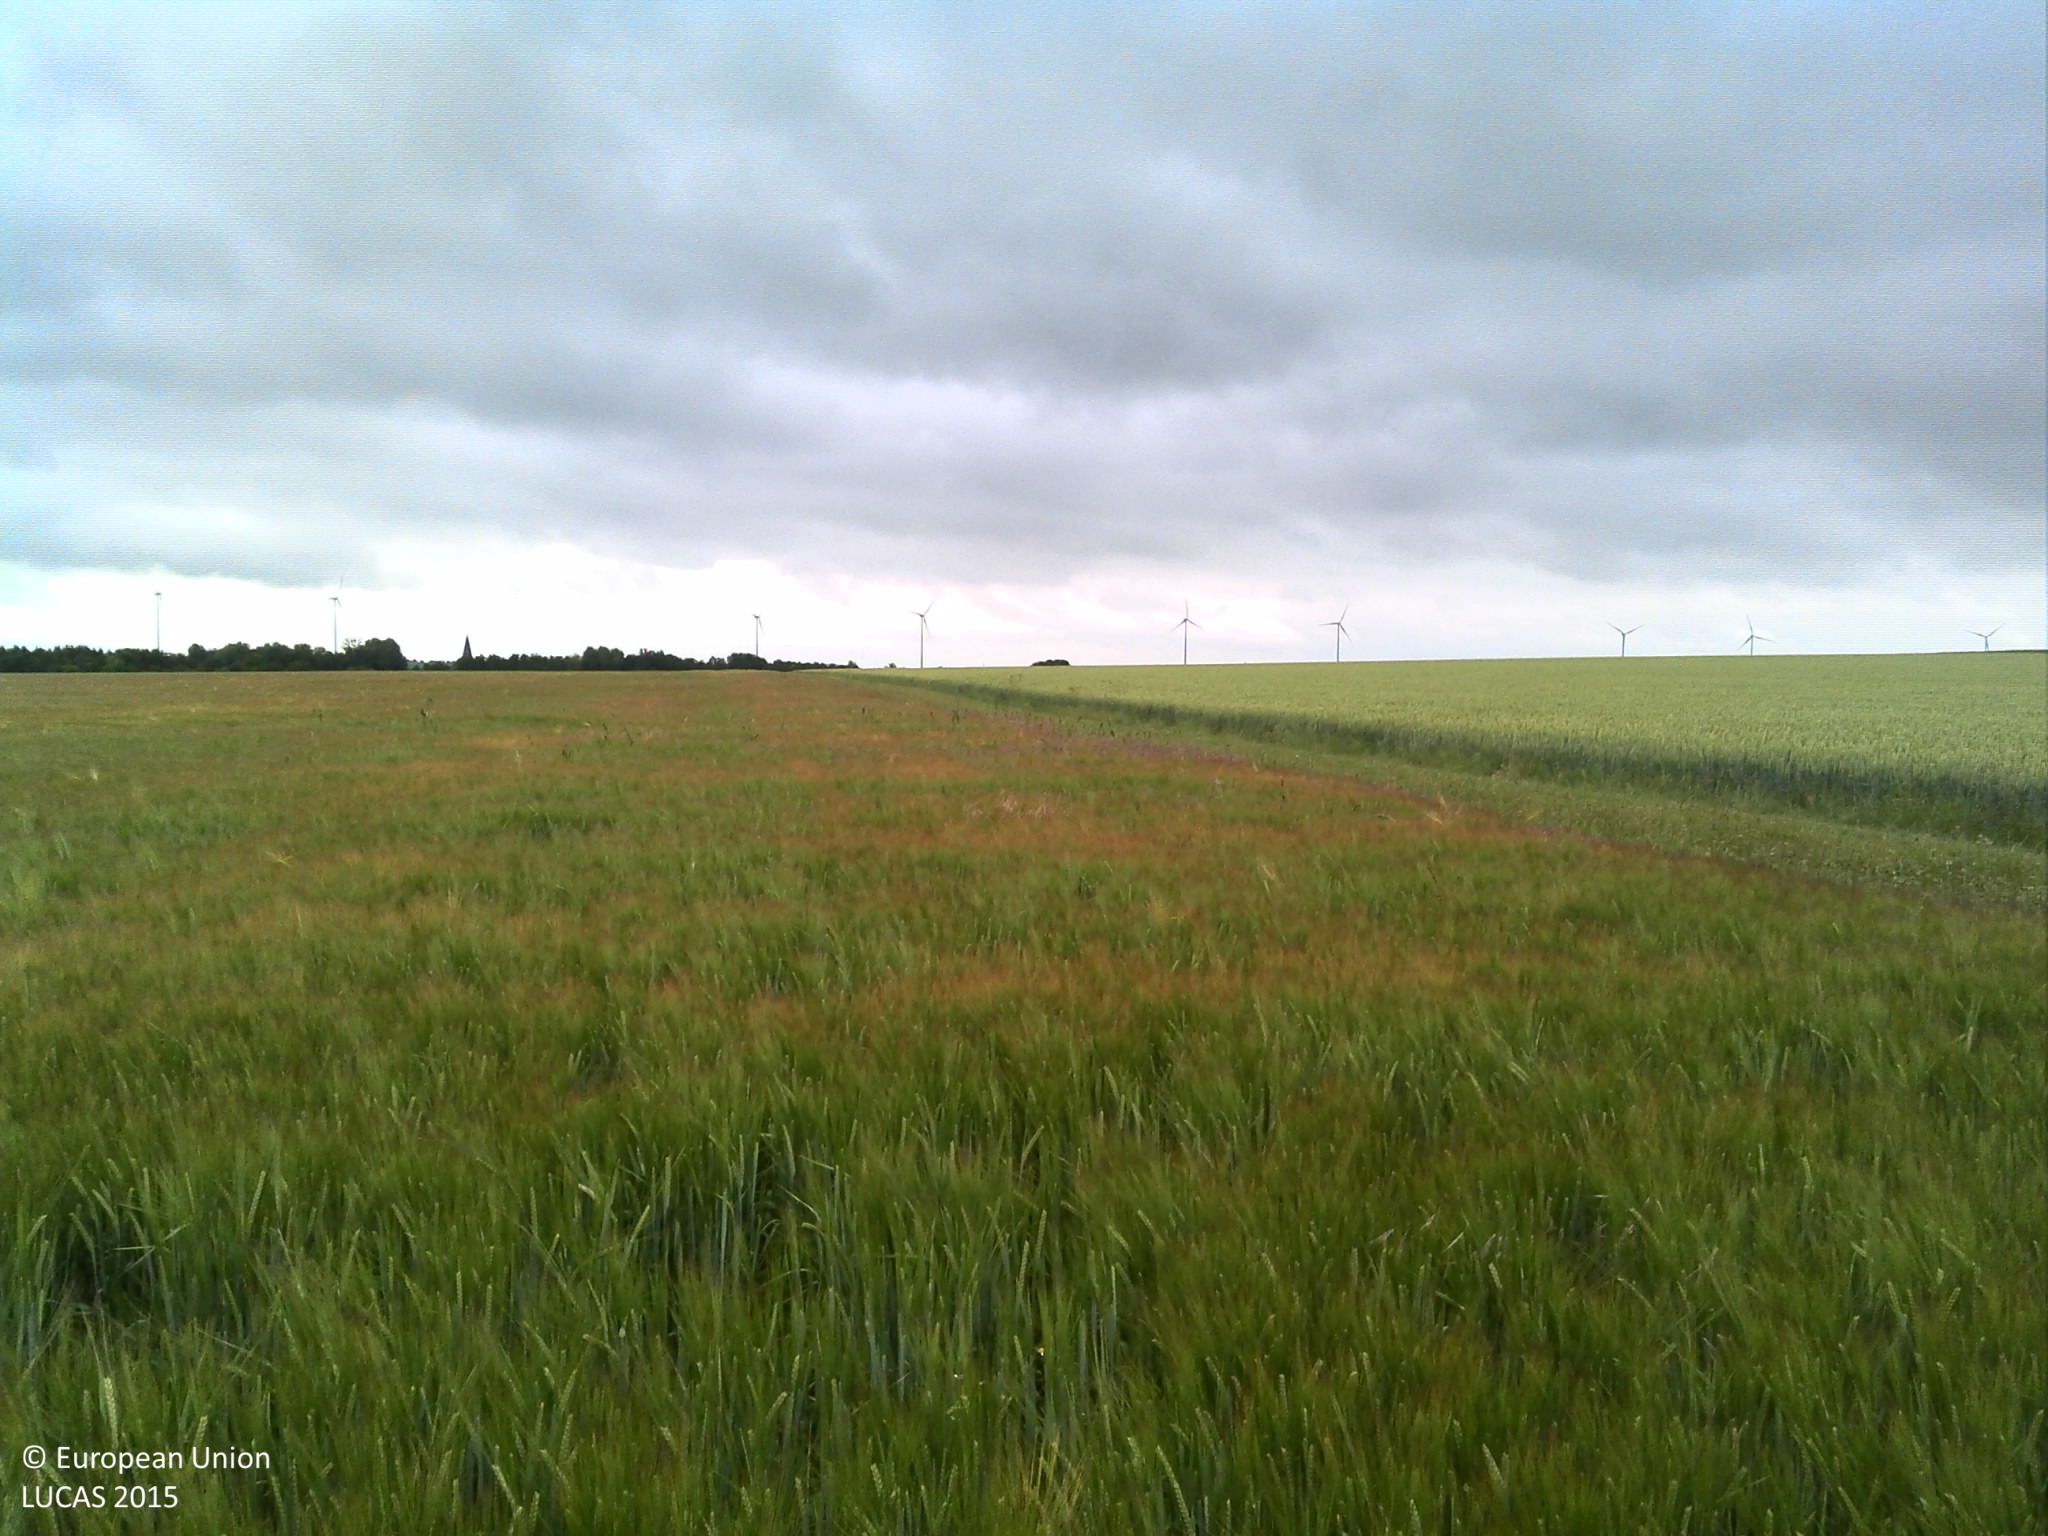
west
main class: Cropland
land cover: Barley
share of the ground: > 75 %
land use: Agriculture (excluding fallow land and kitchen gardens)
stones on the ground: < 10 %
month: June
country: FR
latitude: 48.5792
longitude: 4.2628
